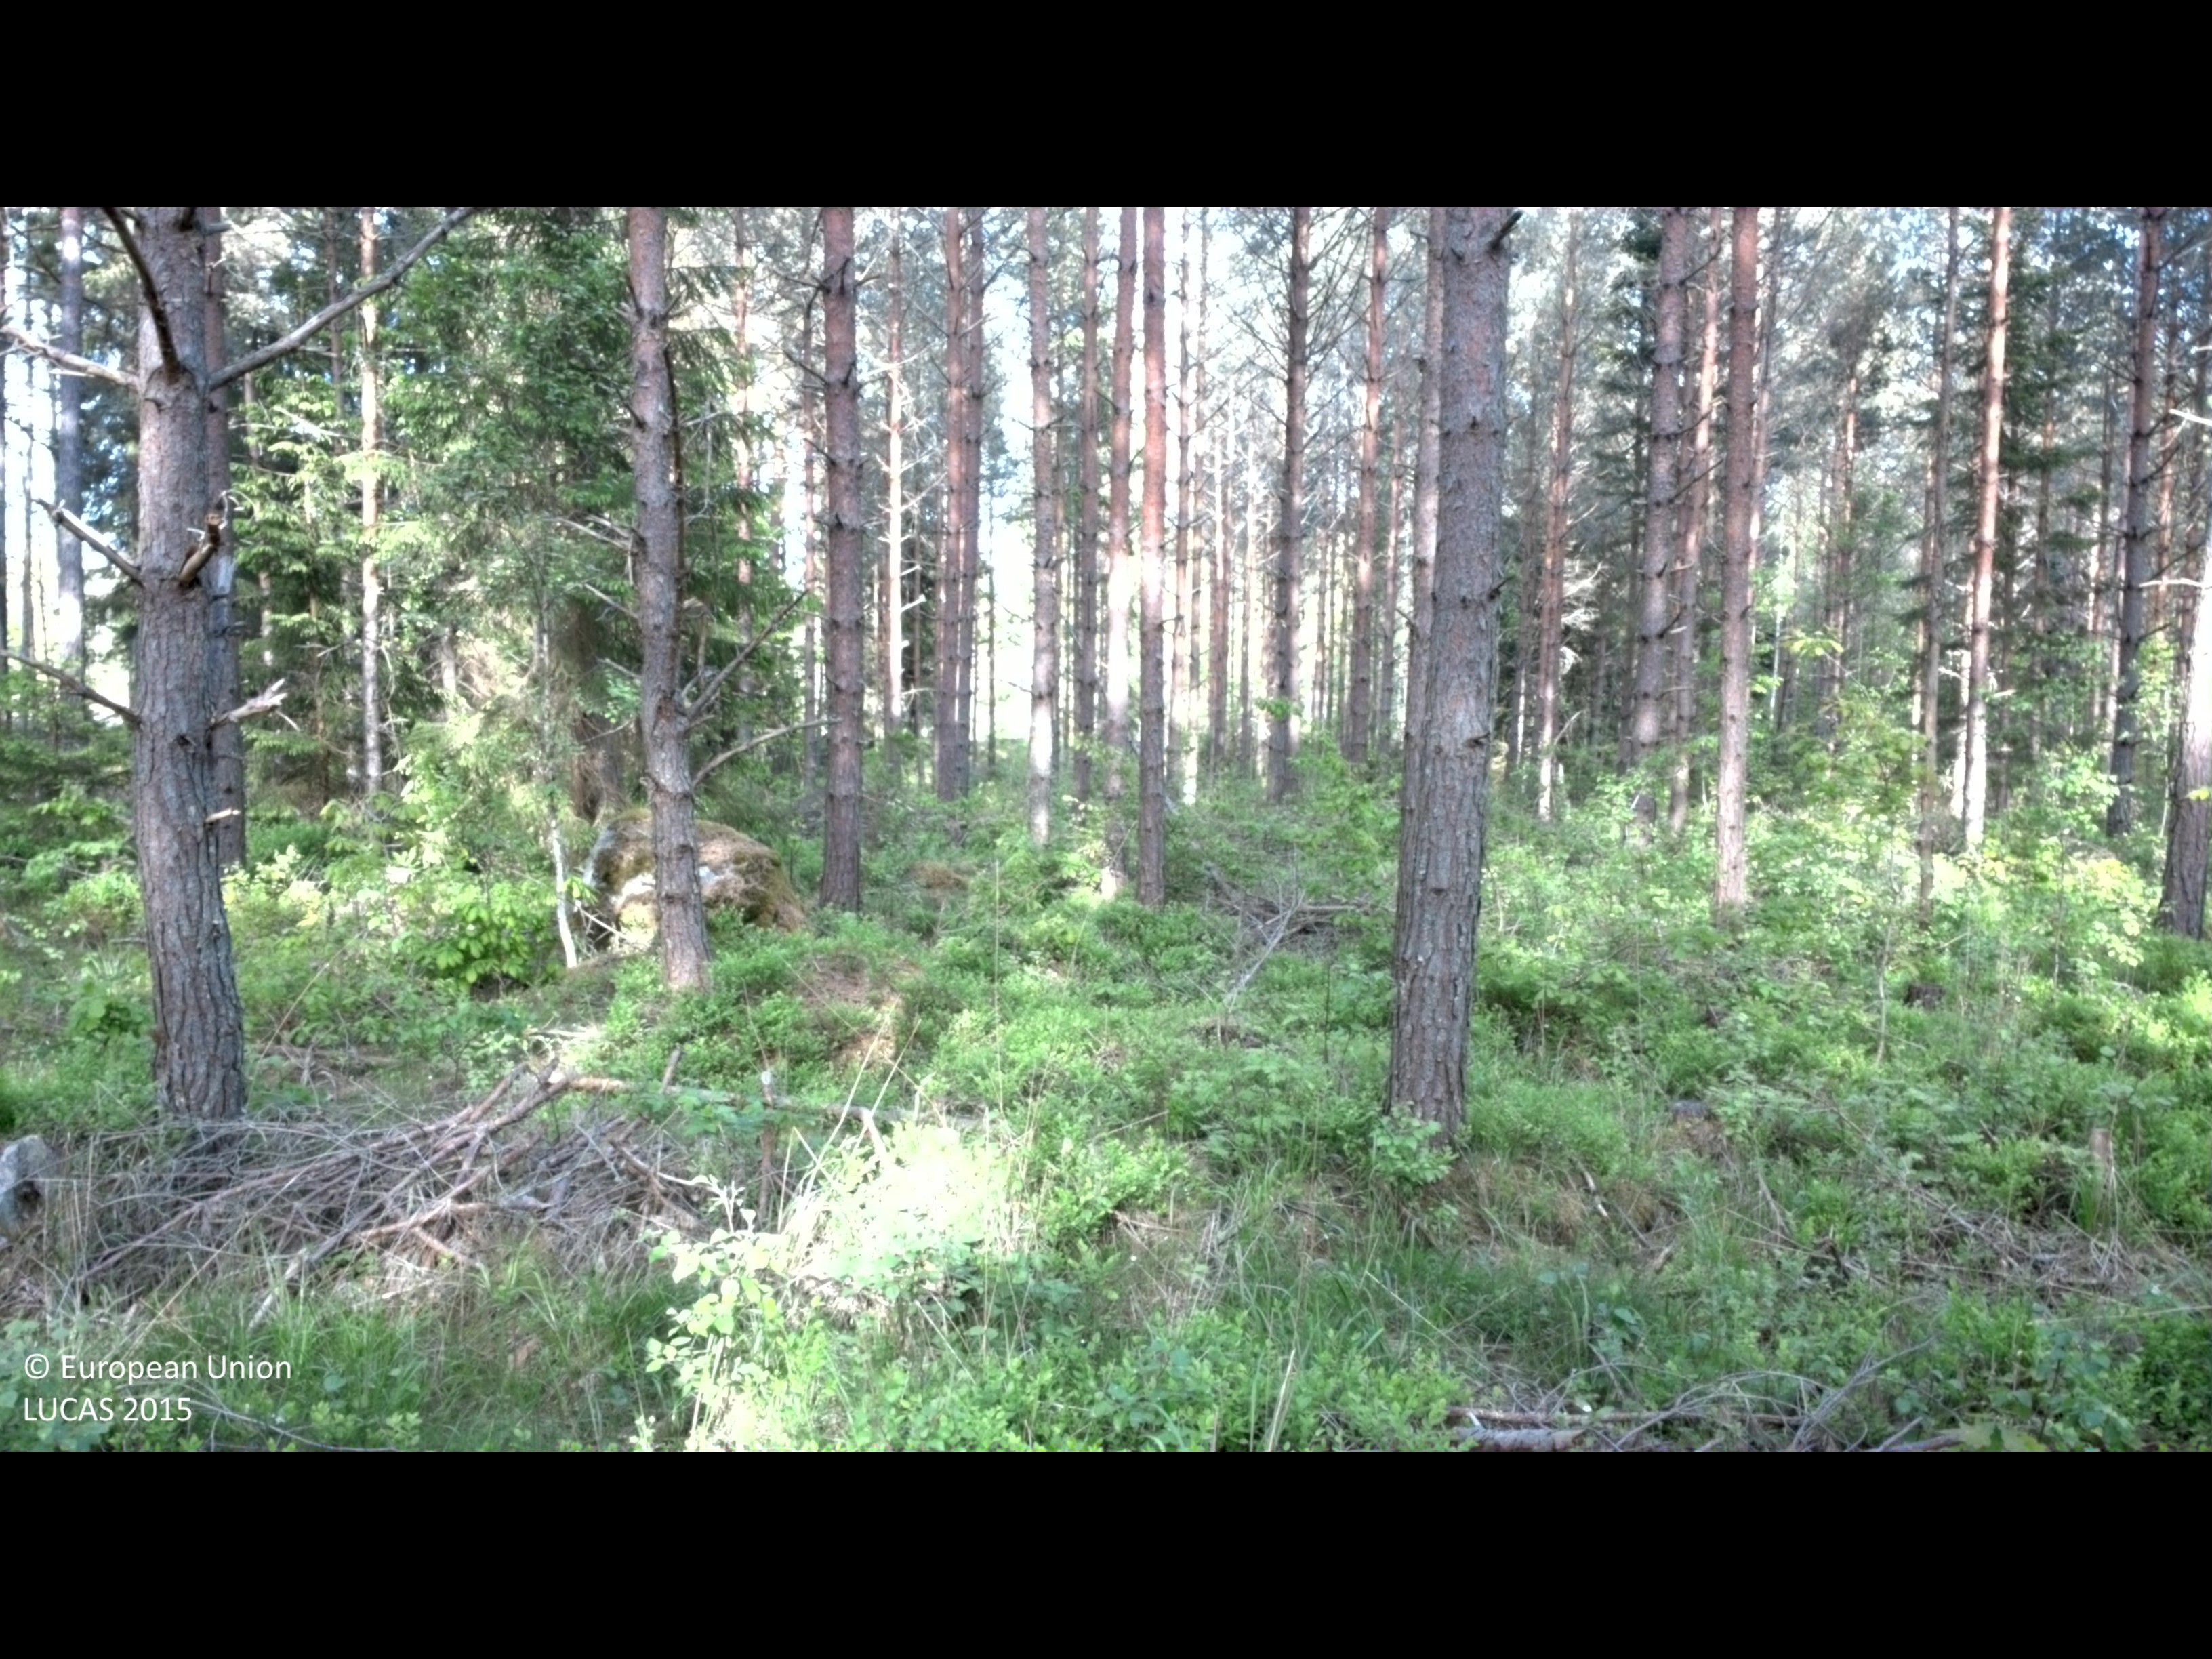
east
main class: Woodland
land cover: Pine dominated coniferous woodland
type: boreal forest
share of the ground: 50 - 75 %
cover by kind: coniferous forest trees 65 %, shrubs 30 %, herbaceous plants 5 %
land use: Forestry
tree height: > 5 m
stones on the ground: 10 - 25 %
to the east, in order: Pine dominated coniferous woodland; Other bare soil; Paved roads, cycling and walking lanes; Broadleaved woodland; Ditches and canals; Pine dominated mixed woodland; Broadleaved woodland
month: June
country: SE
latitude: 57.6054
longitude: 16.2405
